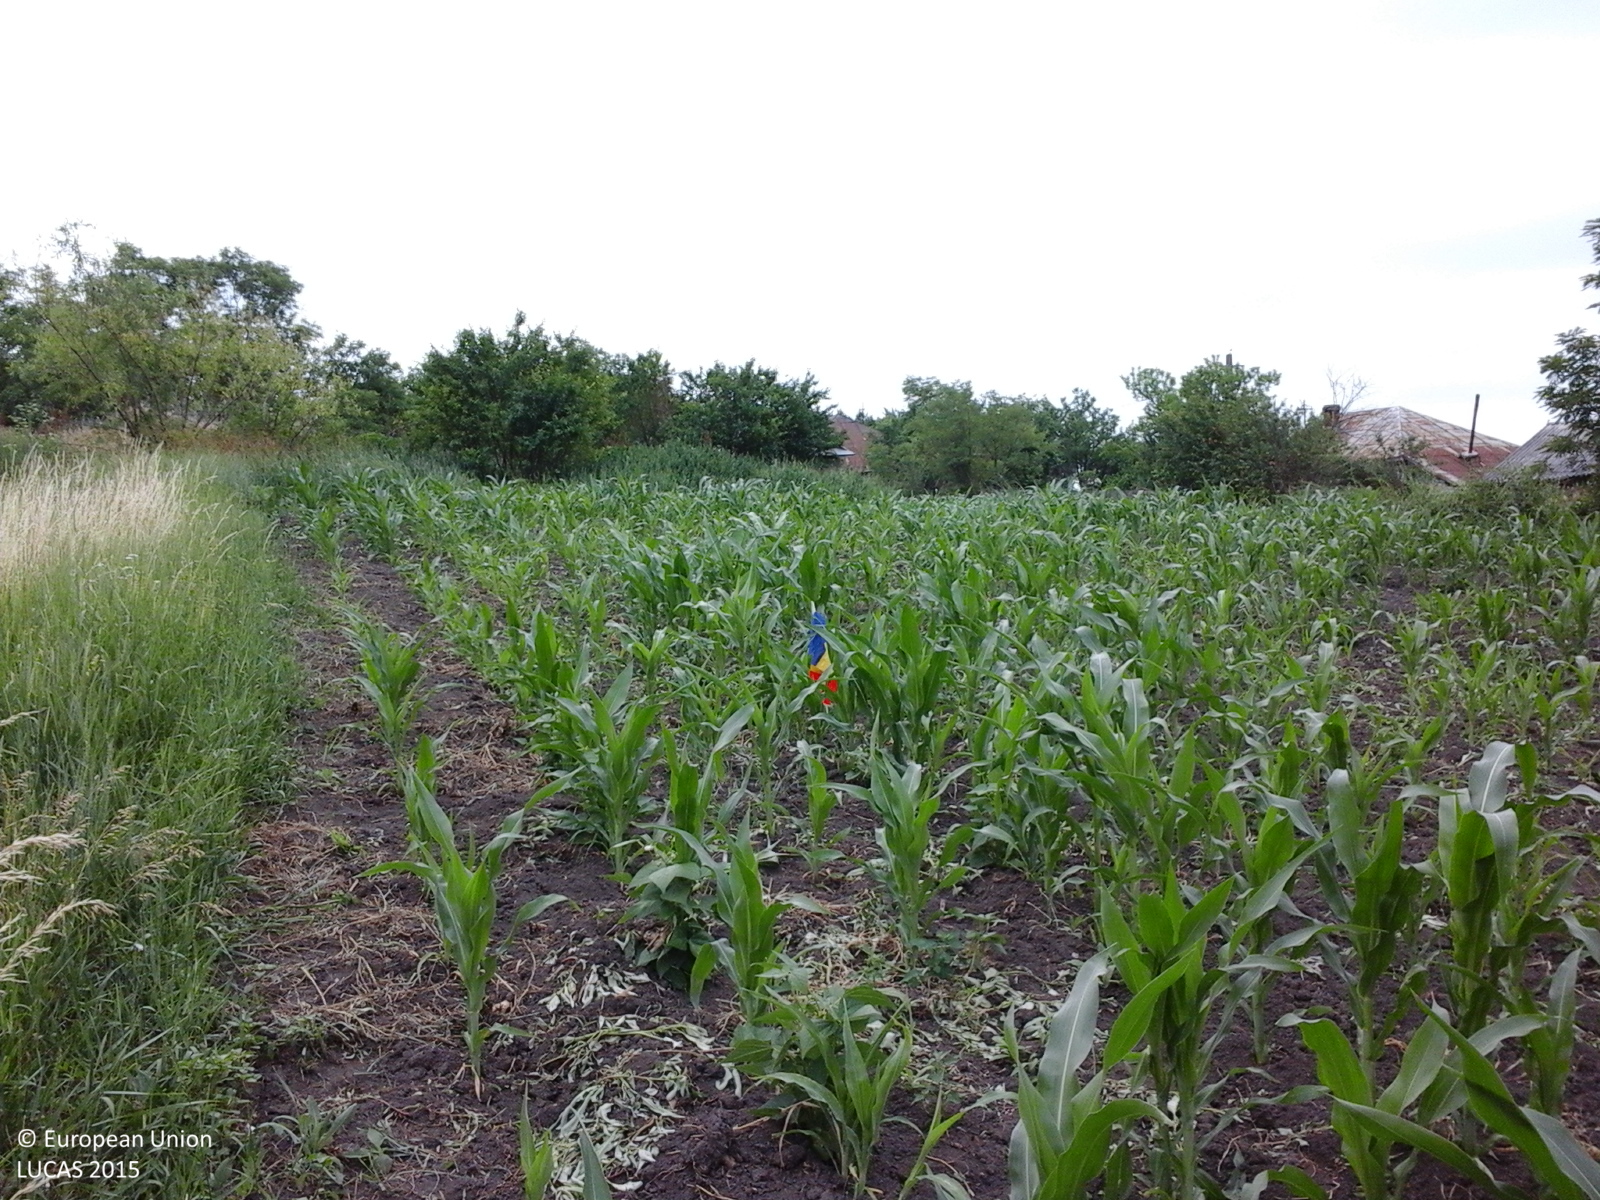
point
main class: Cropland
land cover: Maize
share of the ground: 25 - 50 %
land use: Agriculture (excluding fallow land and kitchen gardens)
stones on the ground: < 10 %
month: June
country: RO
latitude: 47.9608
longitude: 26.4975
